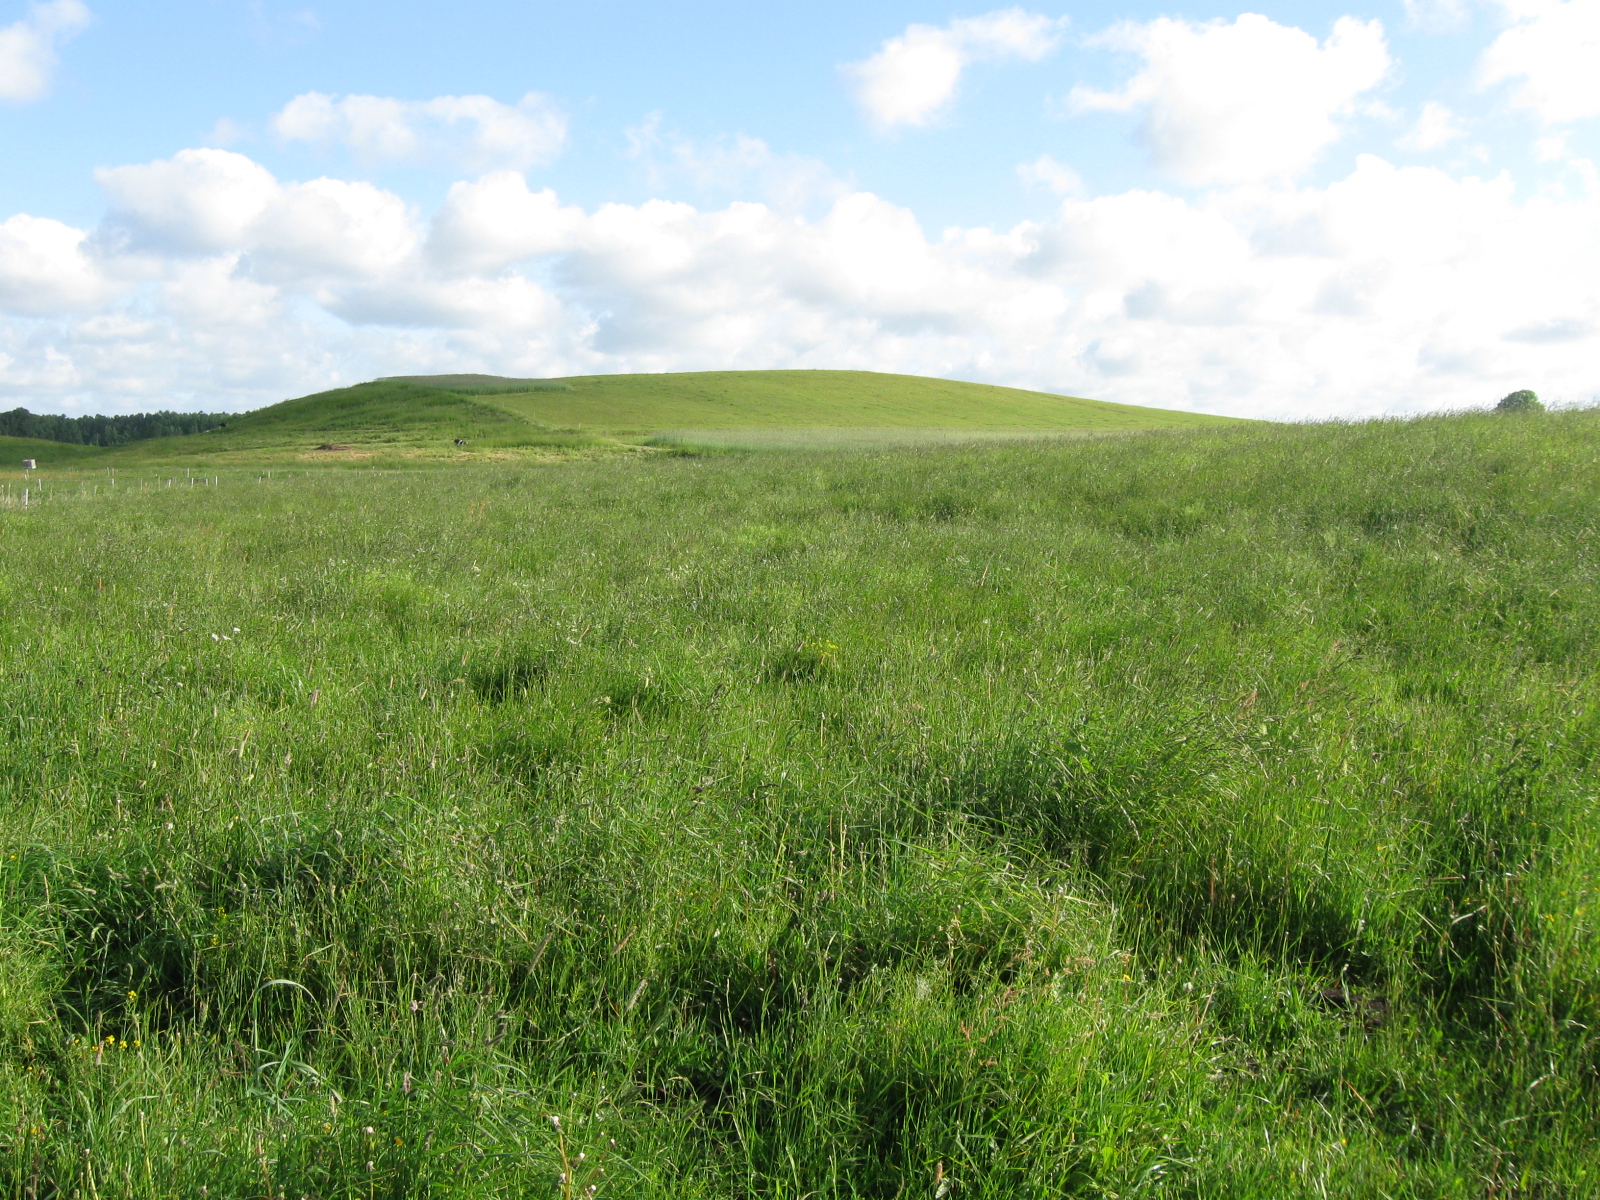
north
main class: Grassland
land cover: Grassland without tree/shrub cover
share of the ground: > 75 %
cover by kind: herbaceous plants 100 %
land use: Agriculture (excluding fallow land and kitchen gardens)
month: June
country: LT
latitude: 54.3668
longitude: 23.8962
